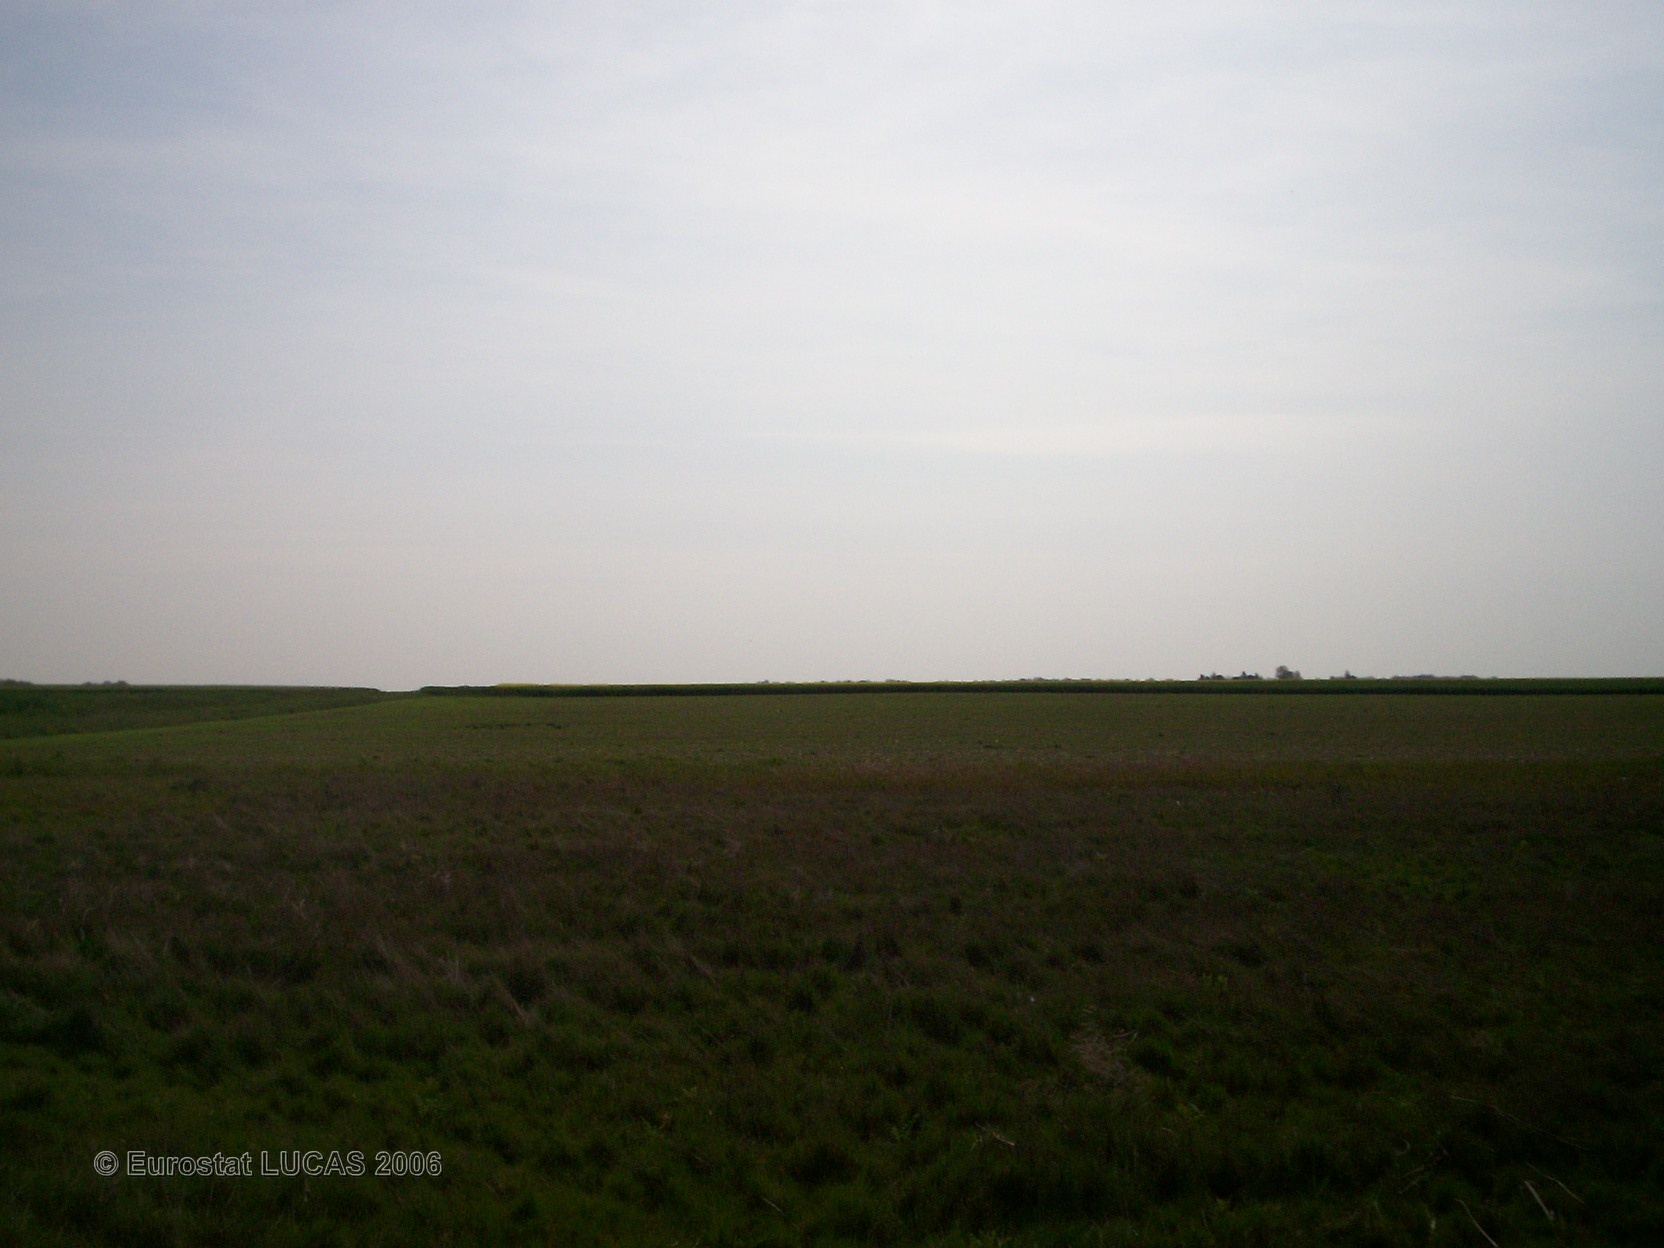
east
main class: Grassland
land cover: Grassland without tree/shrub cover
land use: Agriculture (excluding fallow land and kitchen gardens)
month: May
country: FR
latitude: 48.0825
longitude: 2.8640
